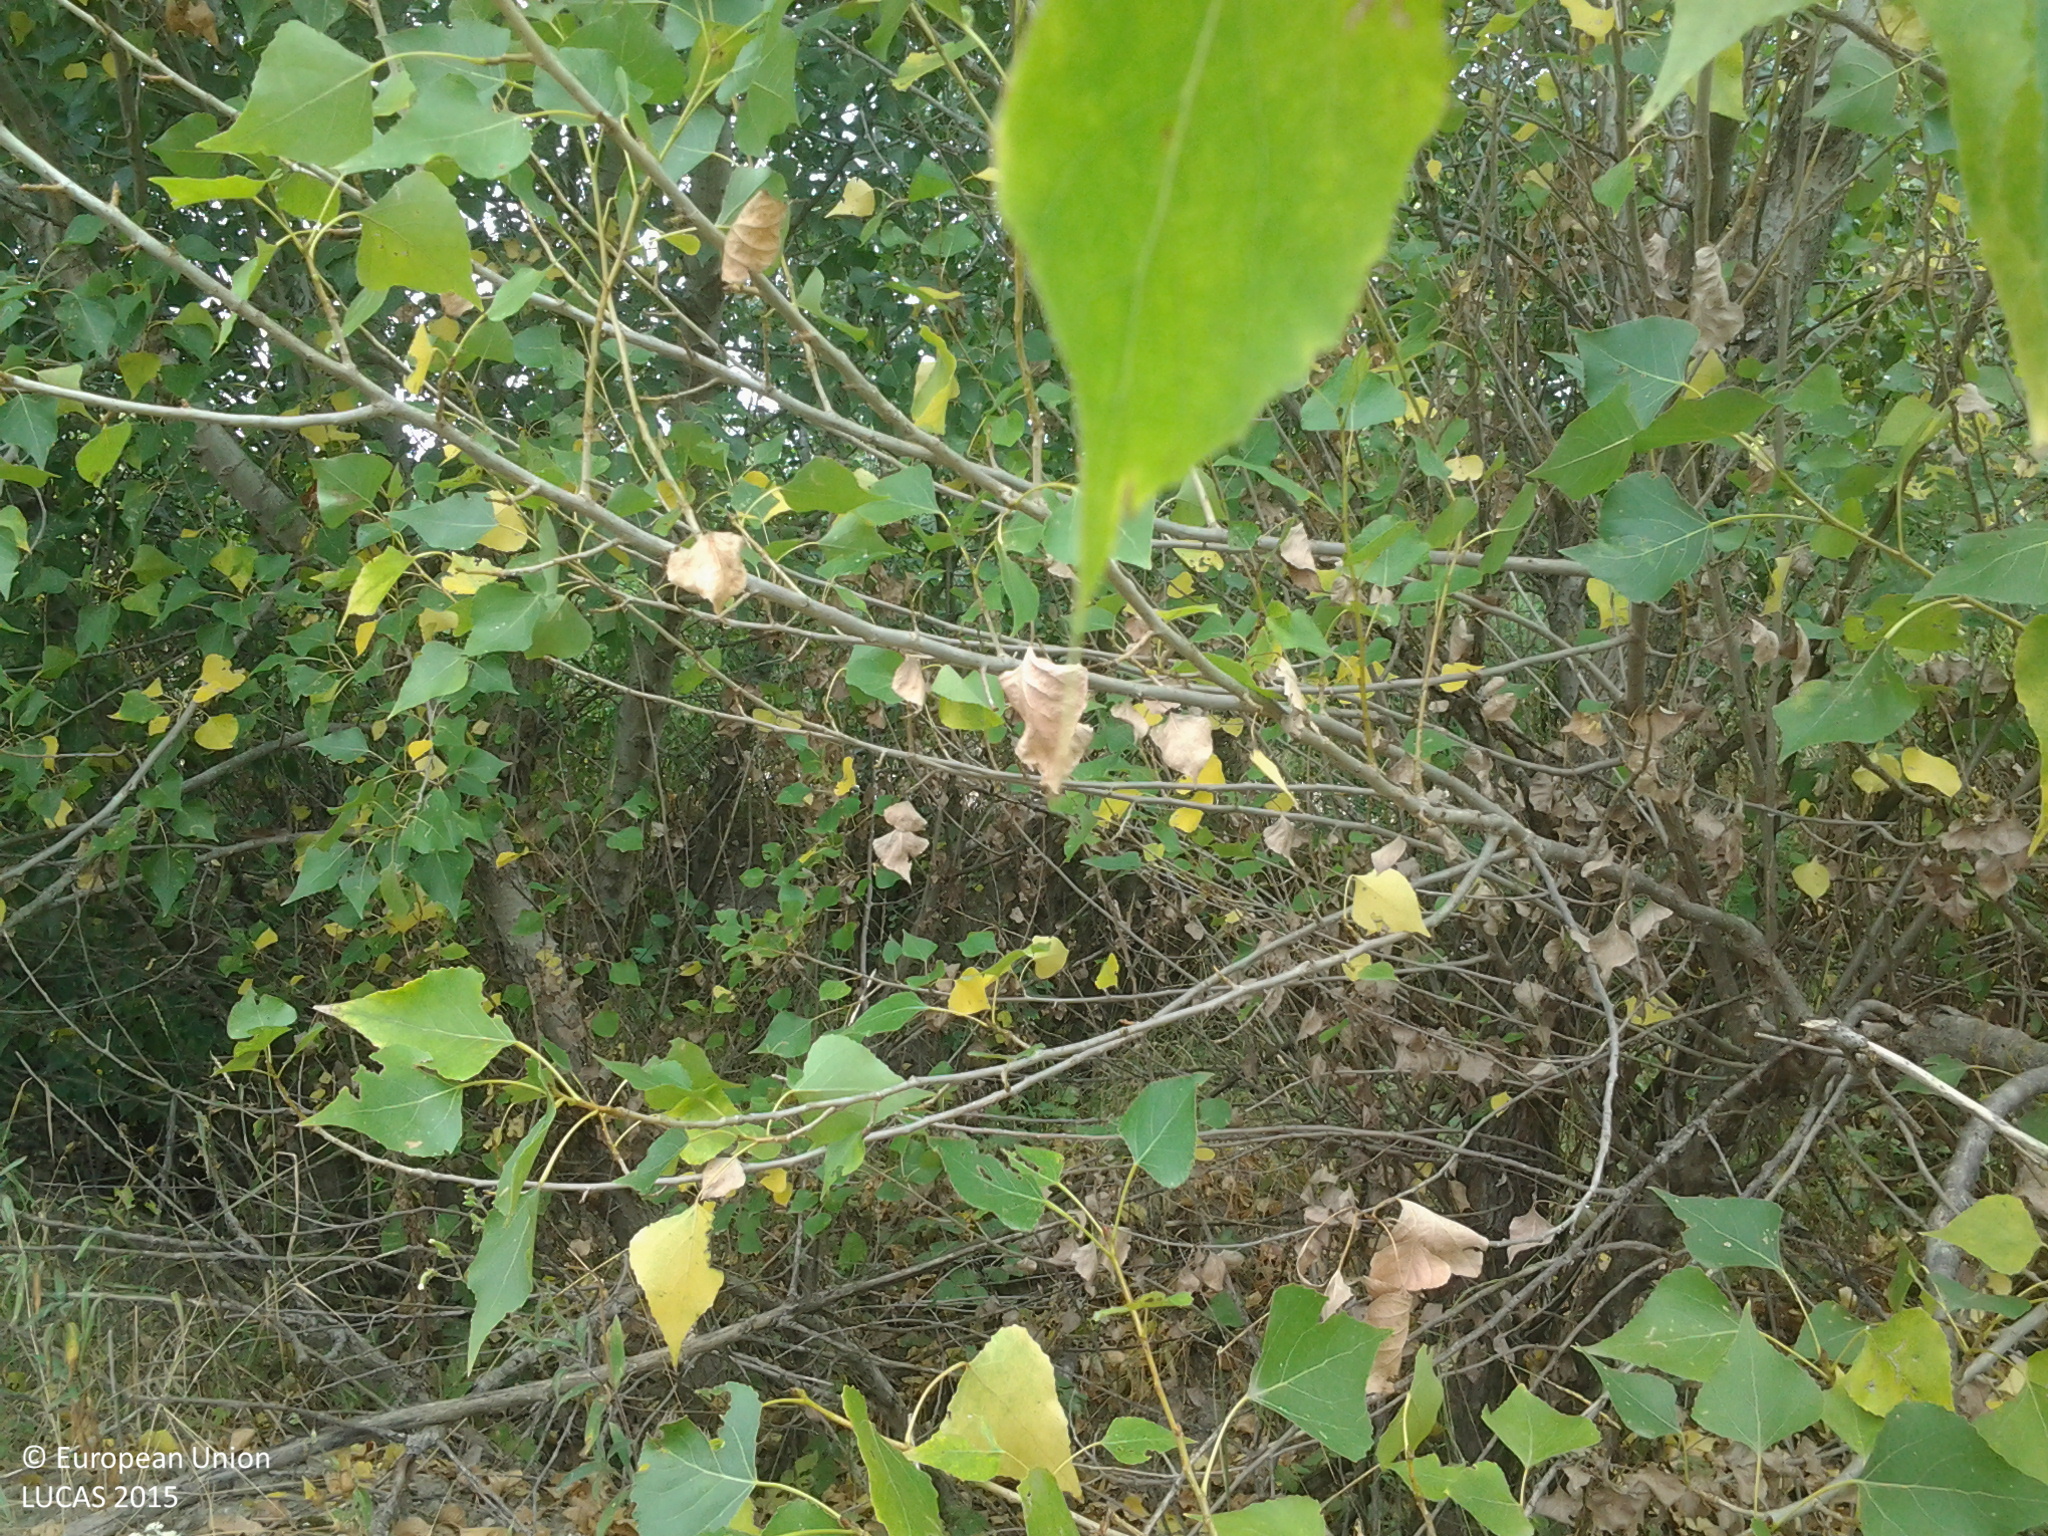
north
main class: Woodland
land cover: Broadleaved woodland
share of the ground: 50 - 75 %
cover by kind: broadleaved forest trees 70 %, herbaceous plants 20 %, shrubs 10 %
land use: Forestry
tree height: > 5 m
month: July
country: HU
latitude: 46.9882
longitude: 18.9693
